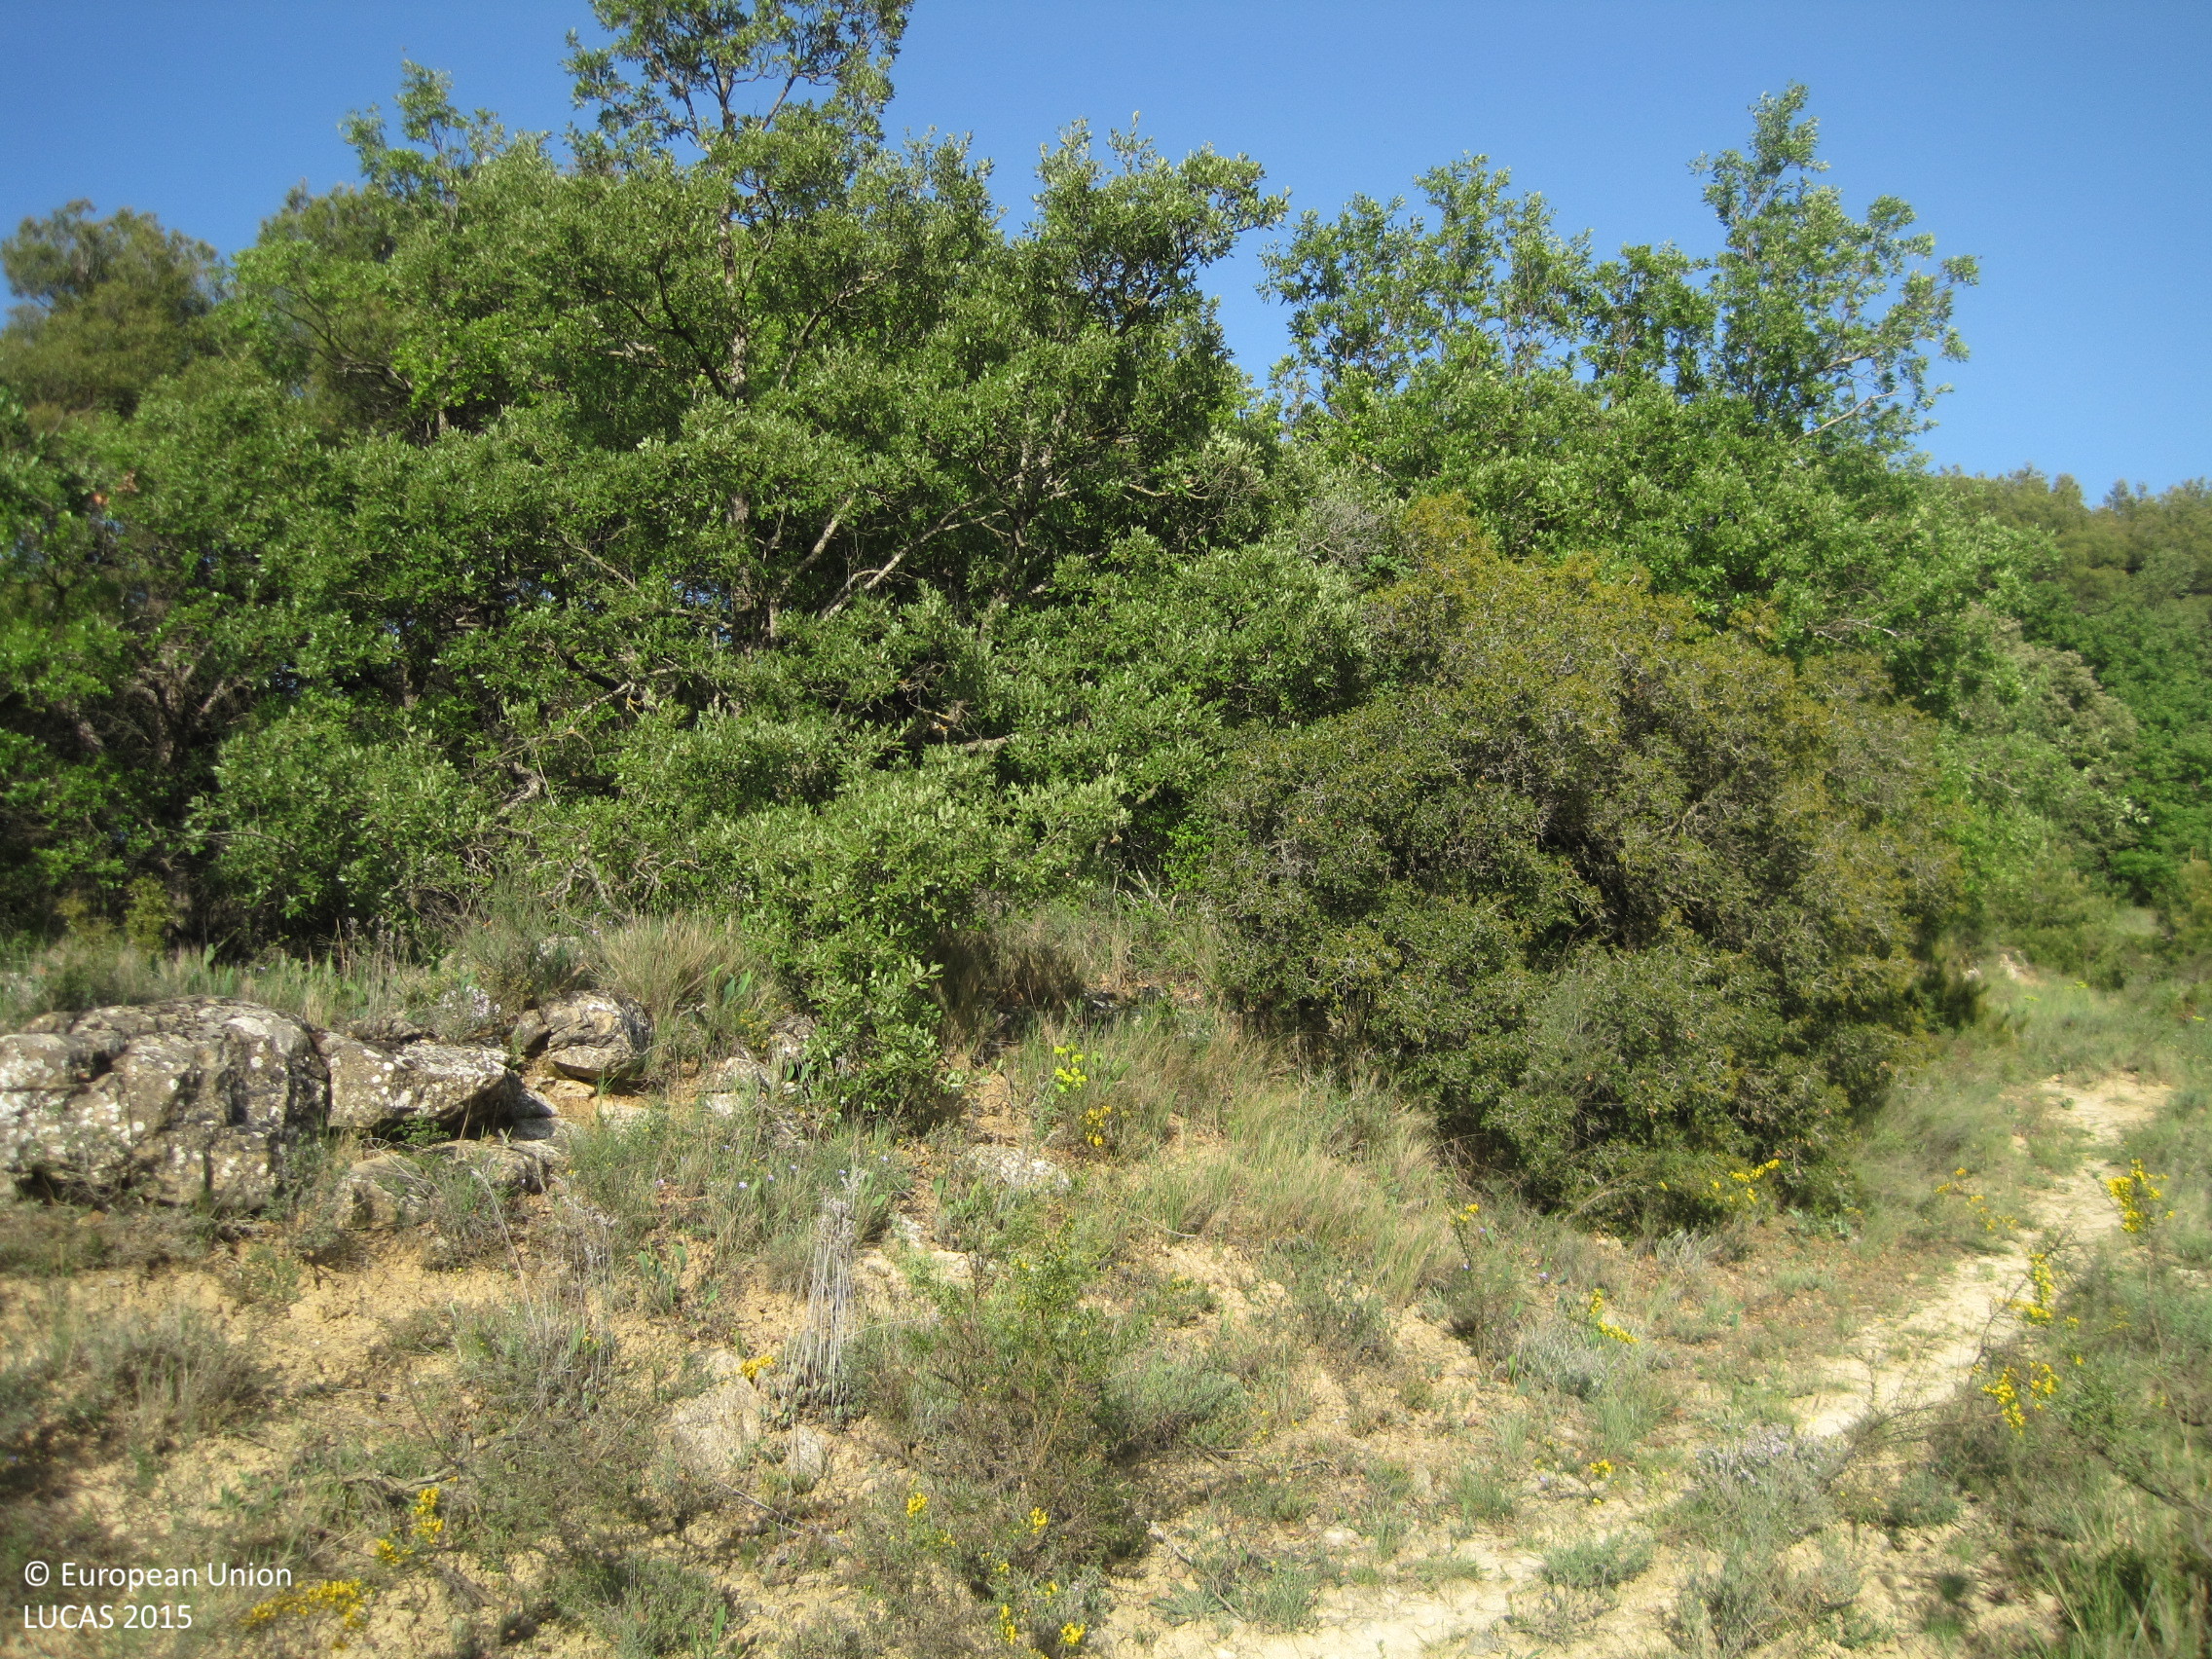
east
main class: Shrubland
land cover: Shrubland with sparse tree cover
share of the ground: > 75 %
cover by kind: shrubs 55 %, herbaceous plants 30 %, unconsolidated bare surface 10 %, broadleaved forest trees 5 %
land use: Semi-natural and natural areas not in use
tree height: < 5 m
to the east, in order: Shrubland with sparse tree cover; Tracks; Broadleaved woodland; Pine dominated coniferous woodland; Broadleaved woodland; Common wheat
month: May
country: ES
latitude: 42.6110
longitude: -1.7038
